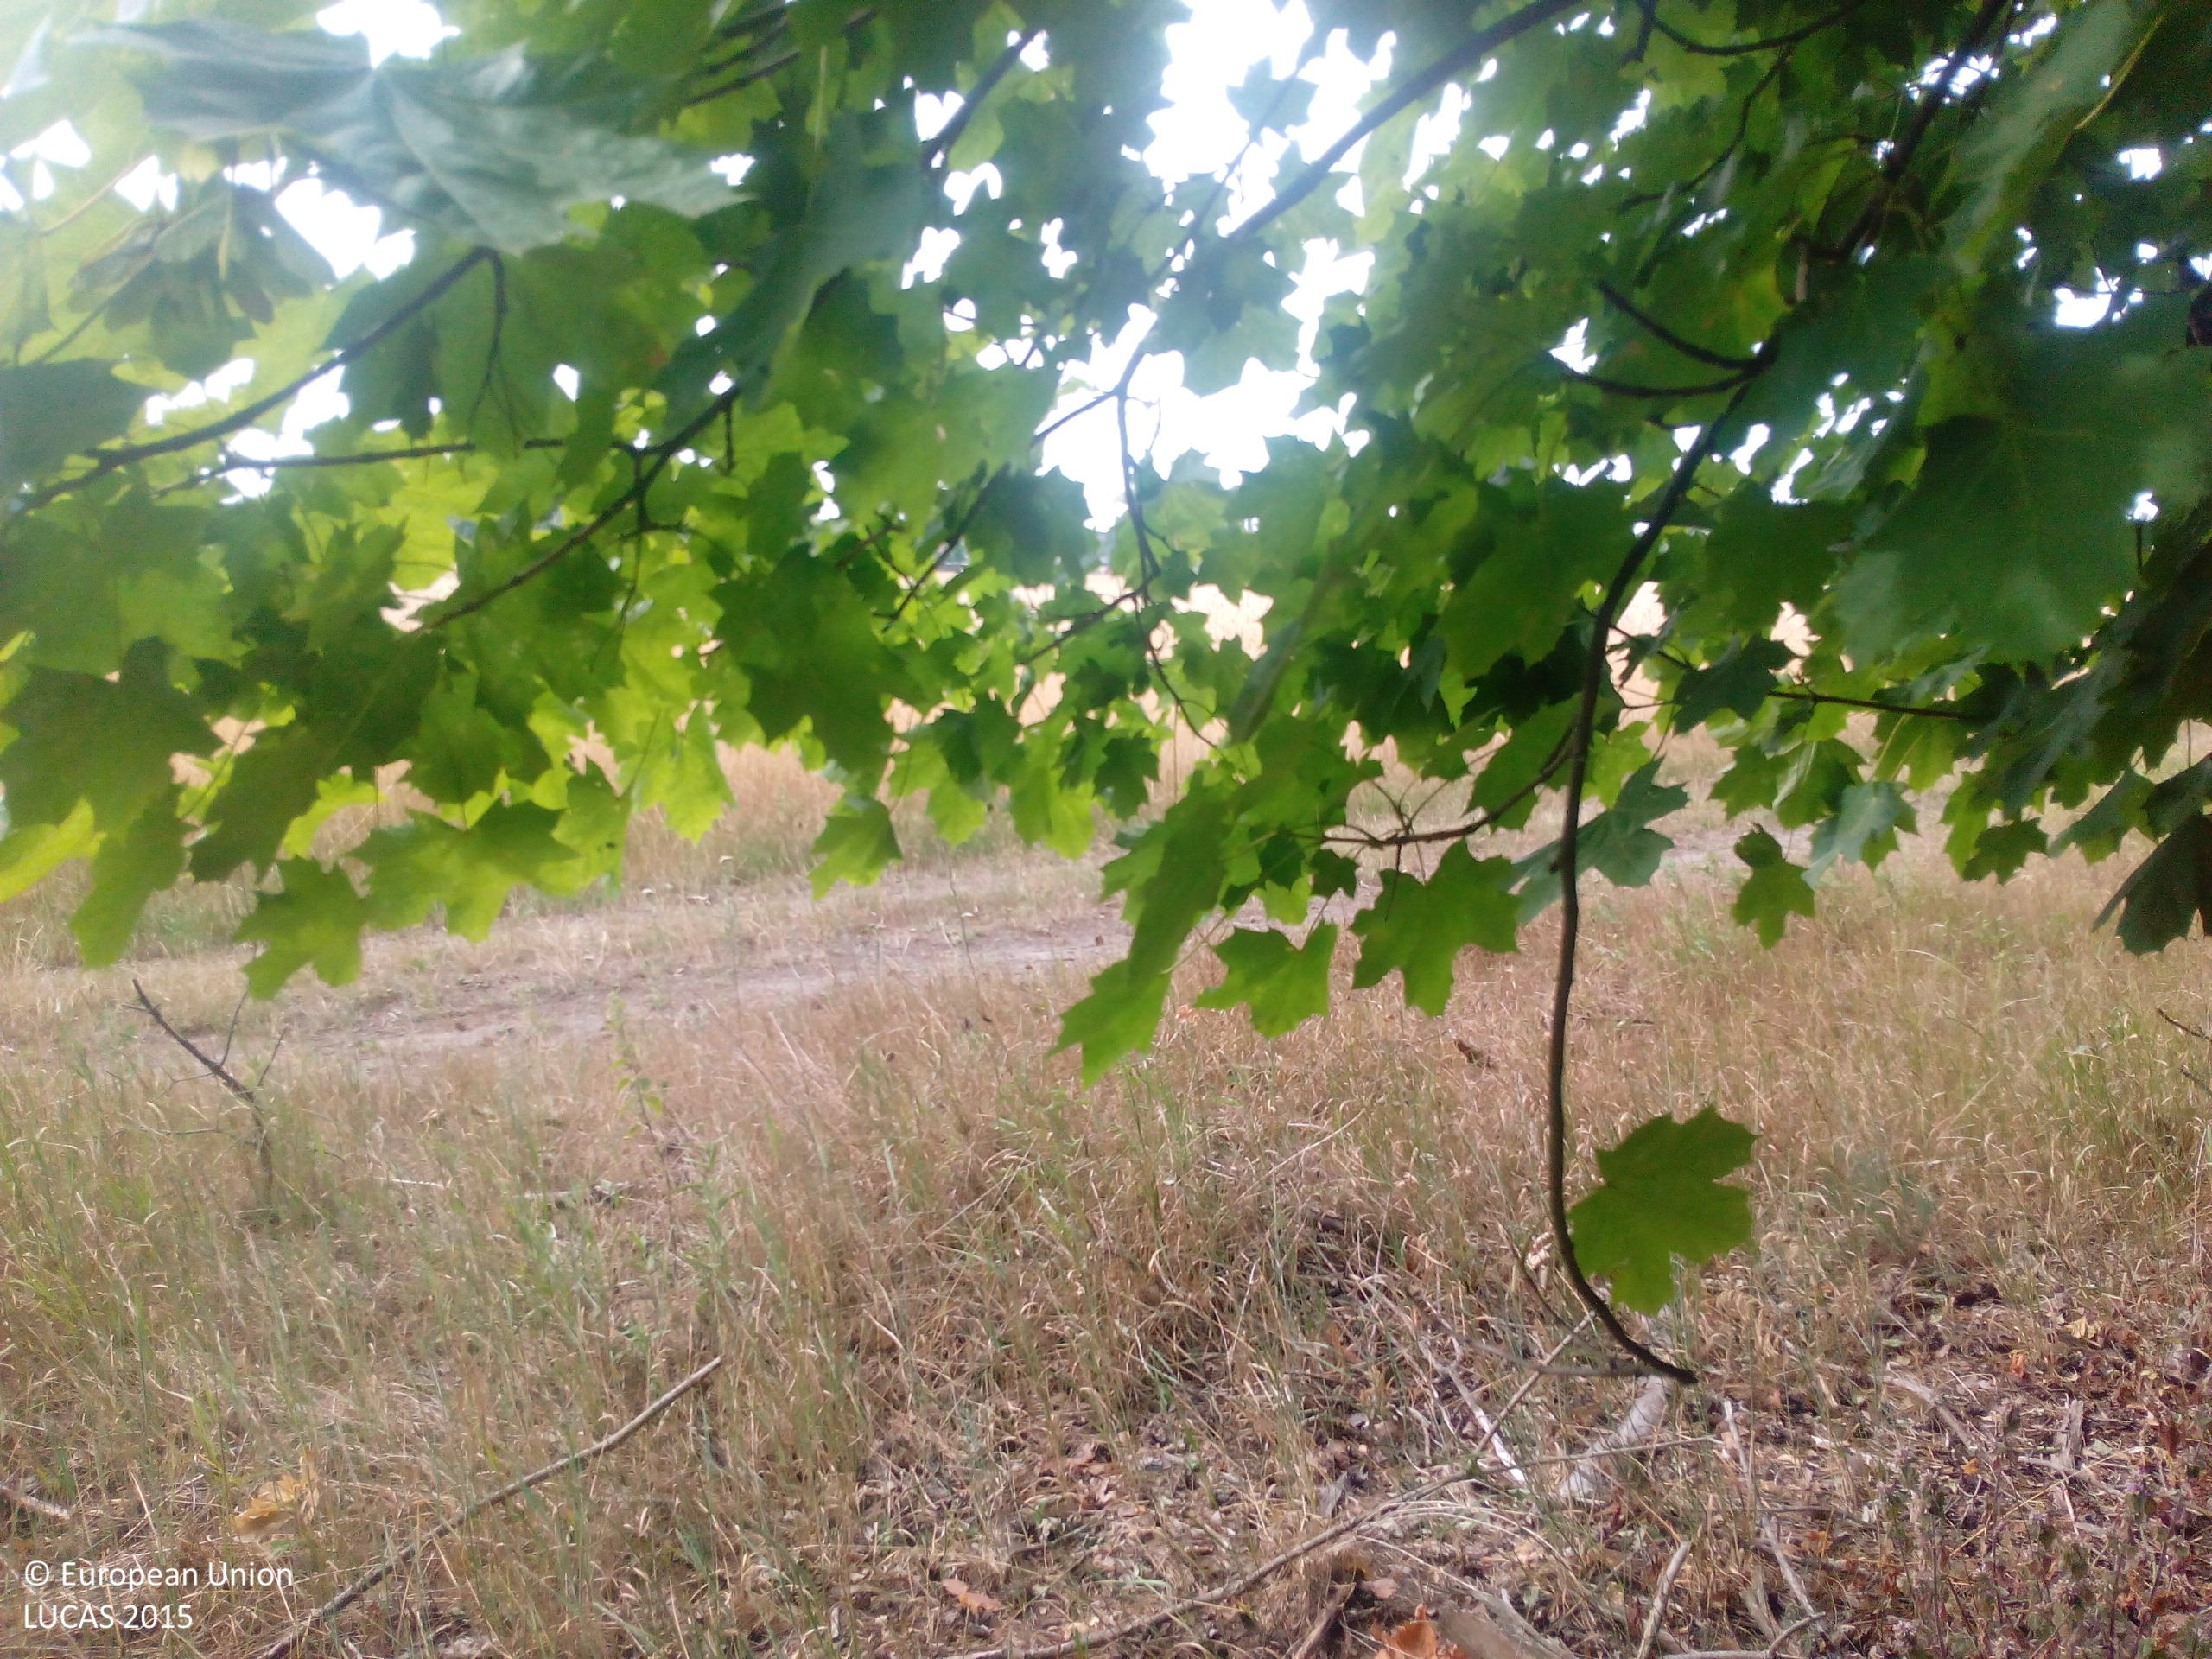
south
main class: Woodland
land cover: Pine dominated mixed woodland
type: hemiboreal forest and nemoral coniferous forest and mixed broadleaved-coniferous forest
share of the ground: > 75 %
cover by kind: coniferous forest trees 70 %, broadleaved forest trees 30 %
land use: Forestry
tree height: > 5 m
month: July
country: DE
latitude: 52.5698
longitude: 11.1357
